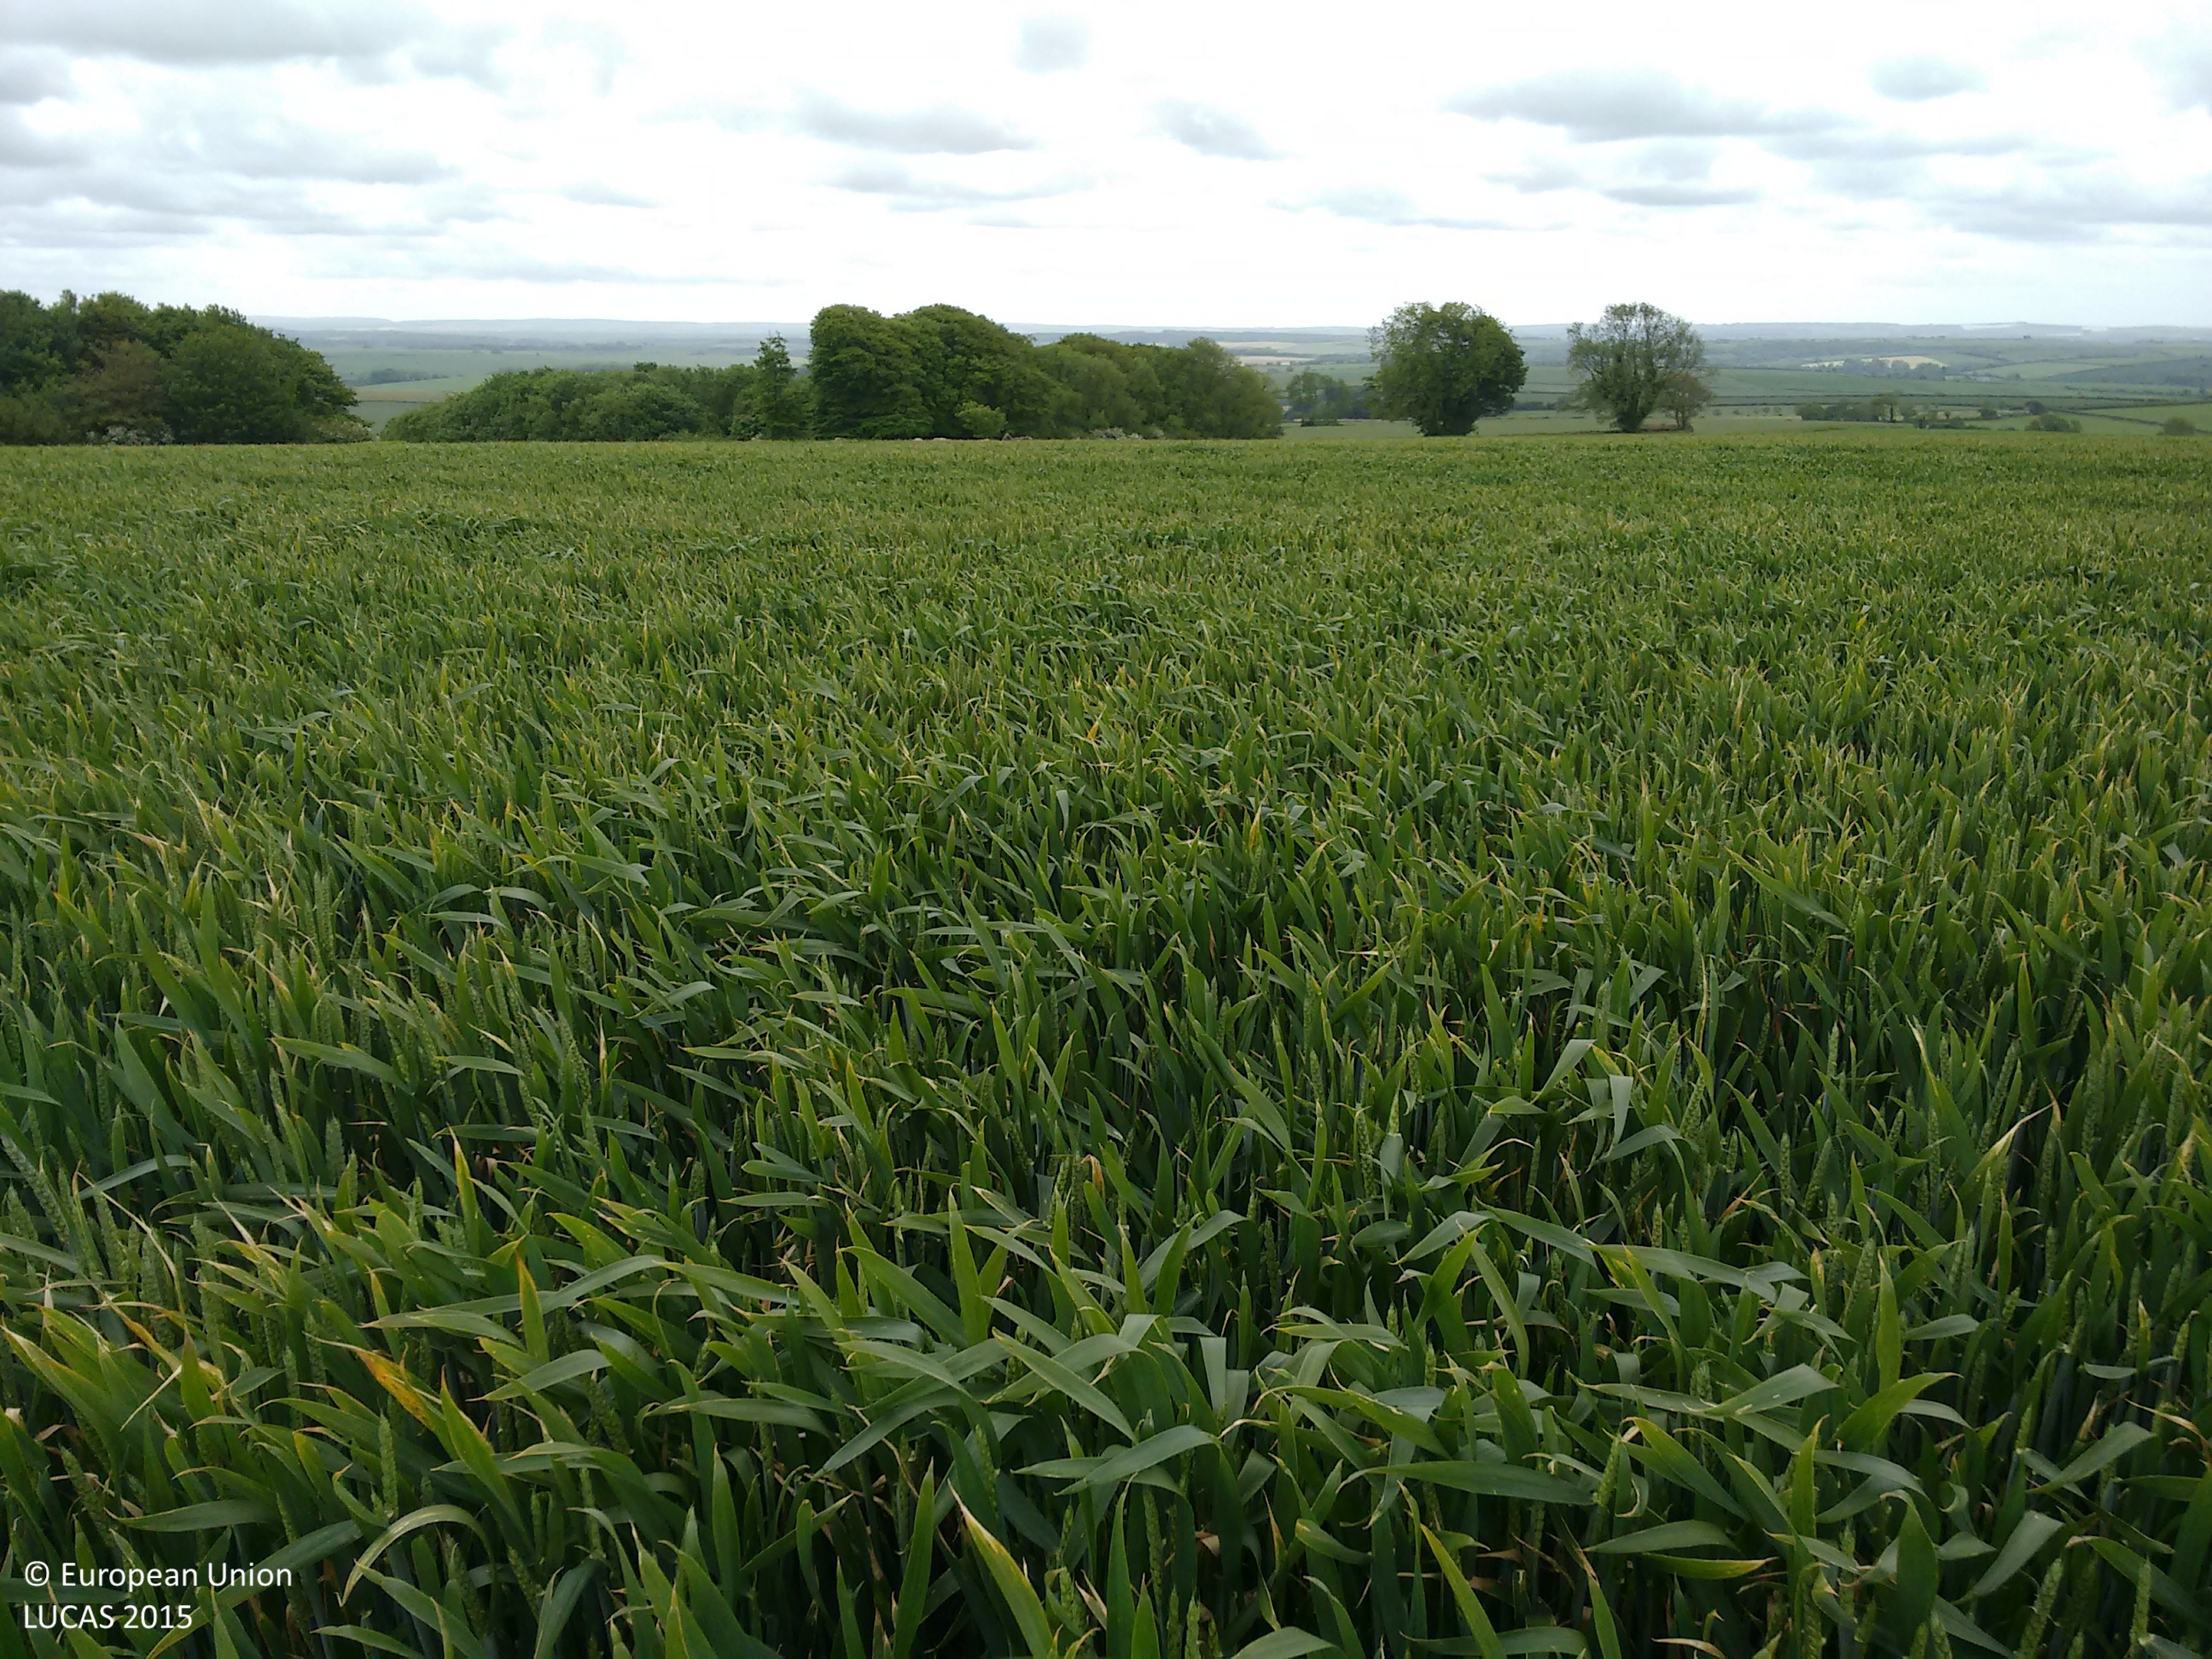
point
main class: Cropland
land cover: Common wheat
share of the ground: > 75 %
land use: Agriculture (excluding fallow land and kitchen gardens)
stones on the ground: > 50 %
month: June
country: GB
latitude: 50.8145
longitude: -2.3982
